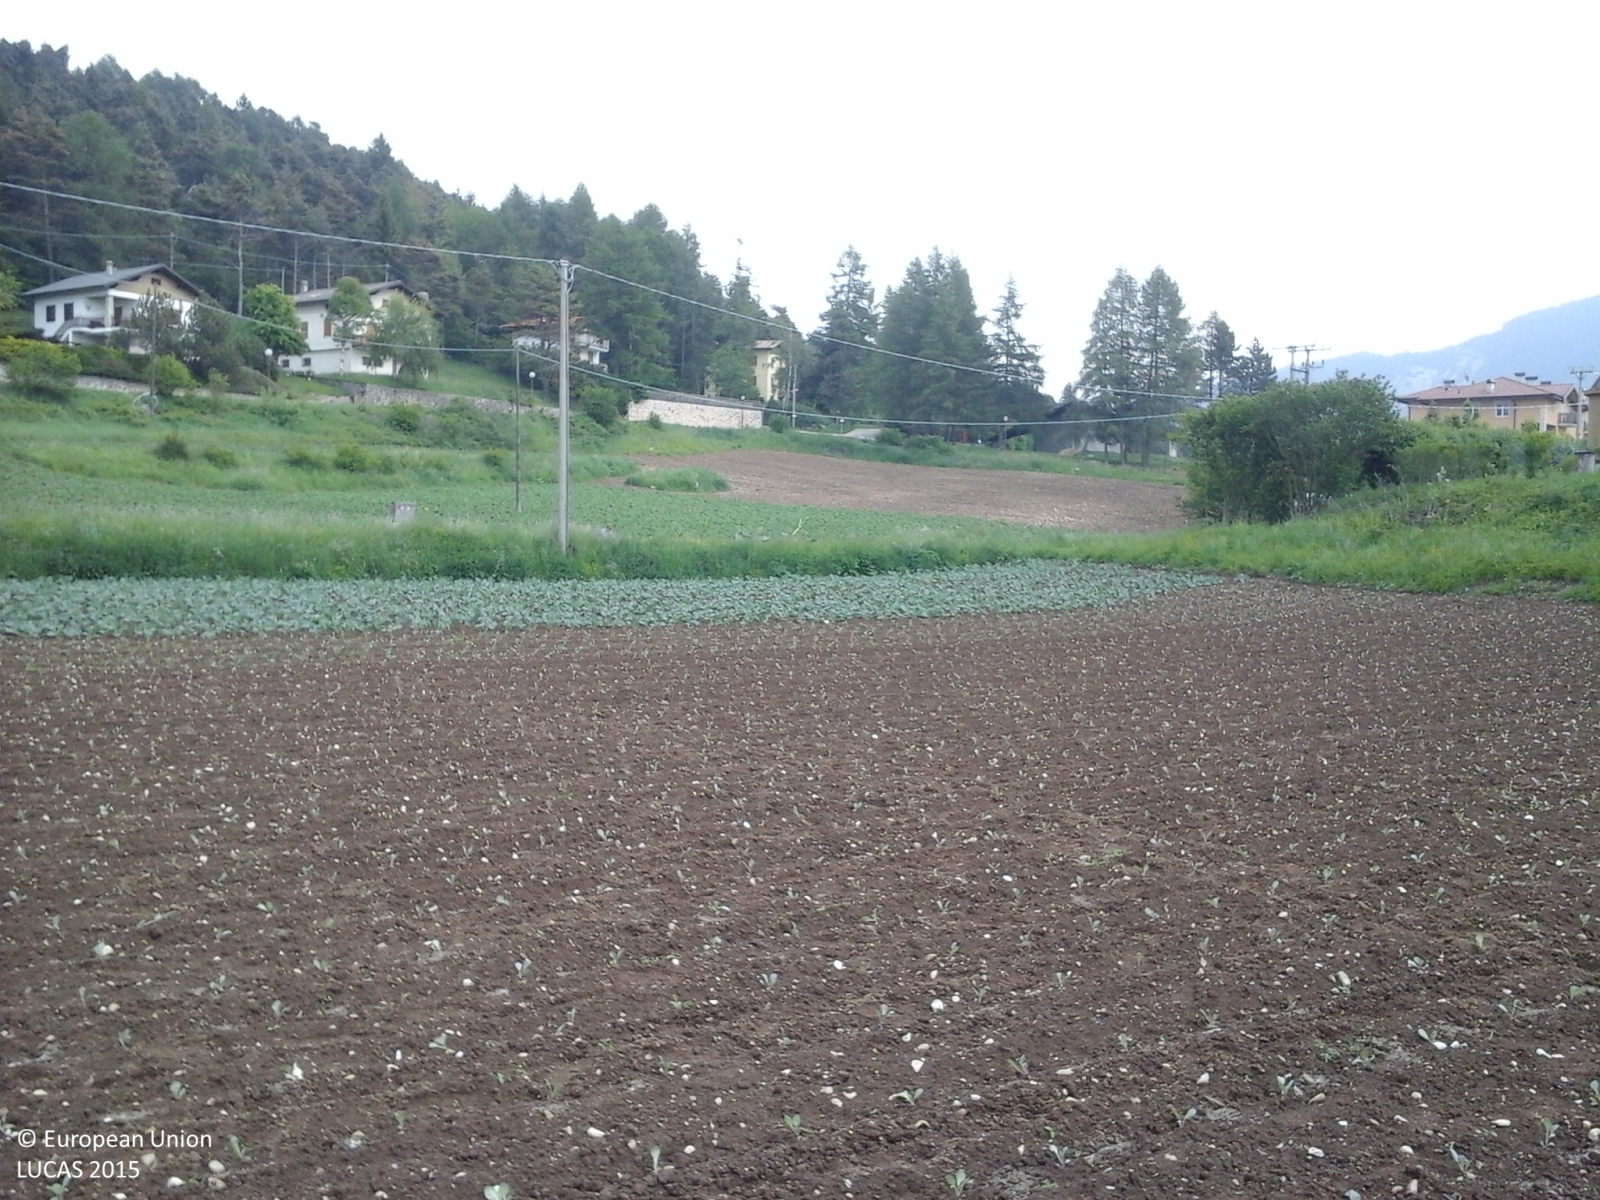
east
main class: Cropland
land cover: Other fresh vegetables
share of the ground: < 10 %
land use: Agriculture (excluding fallow land and kitchen gardens)
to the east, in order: Other fresh vegetables; Grass margins; Electric lines; Tracks; Grass margins; Potatoes; Electric lines; Potatoes; Other fresh vegetables; Grass margins; Paved roads, cycling and walking lanes; Broadleaved woodland
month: June
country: IT
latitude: 45.8967
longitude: 10.9394
